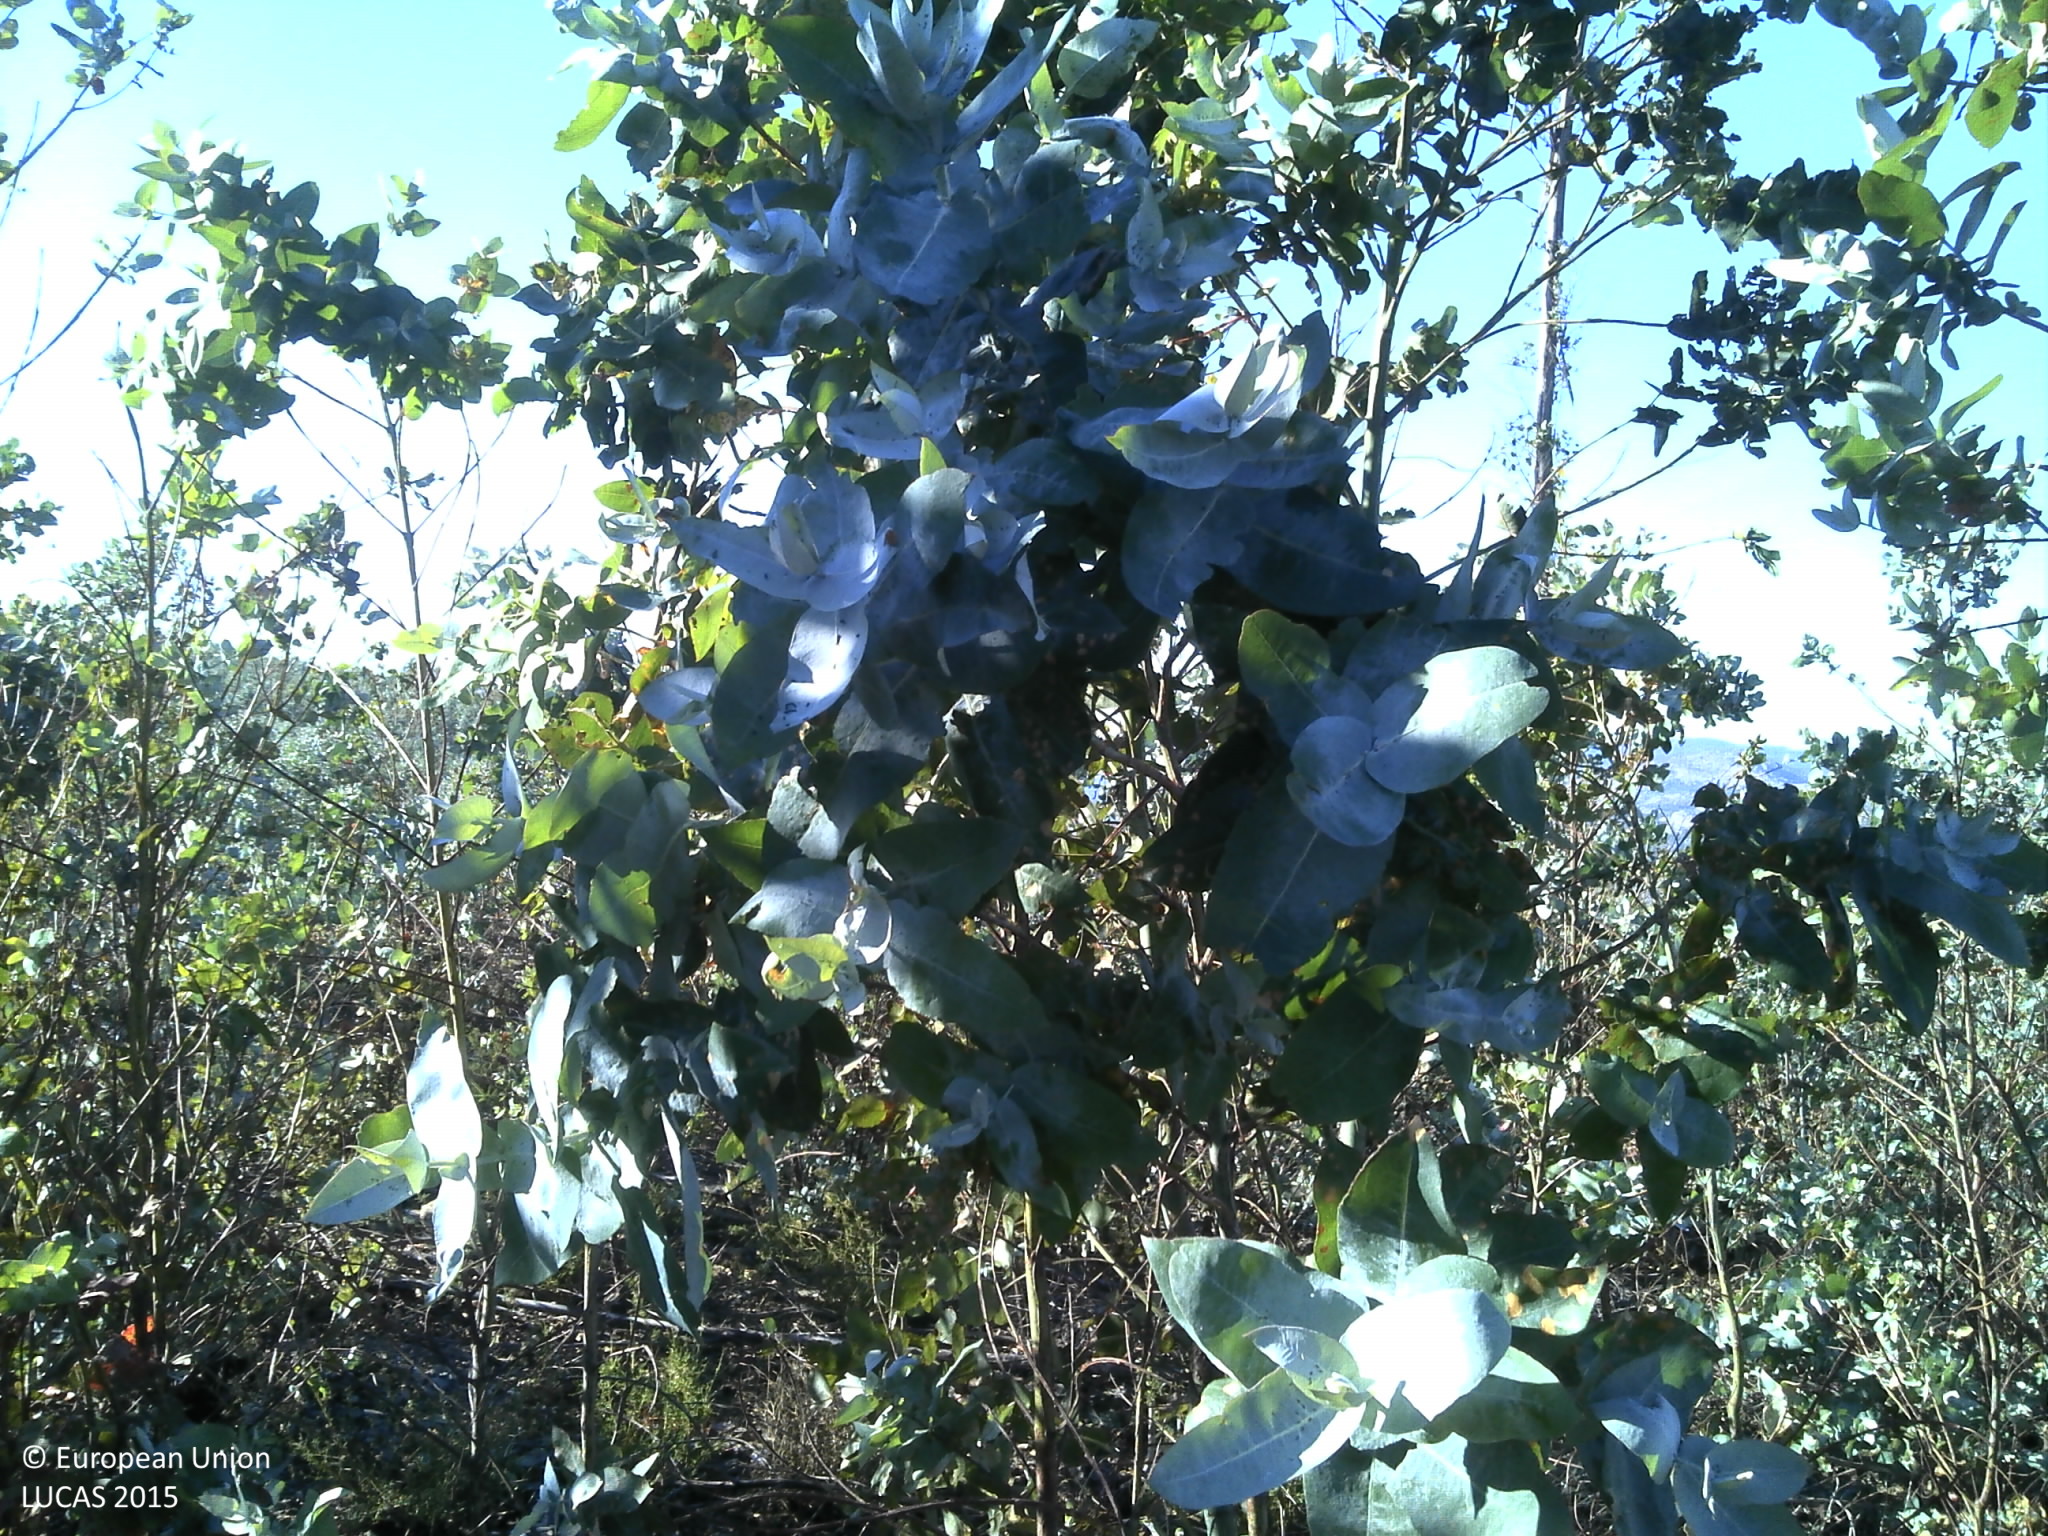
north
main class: Woodland
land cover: Broadleaved woodland
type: exotic forest
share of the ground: 25 - 50 %
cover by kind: unconsolidated bare surface 65 %, broadleaved forest trees 25 %, shrubs 10 %
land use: Forestry
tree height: < 5 m
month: June
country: PT
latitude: 40.5483
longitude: -8.2818
